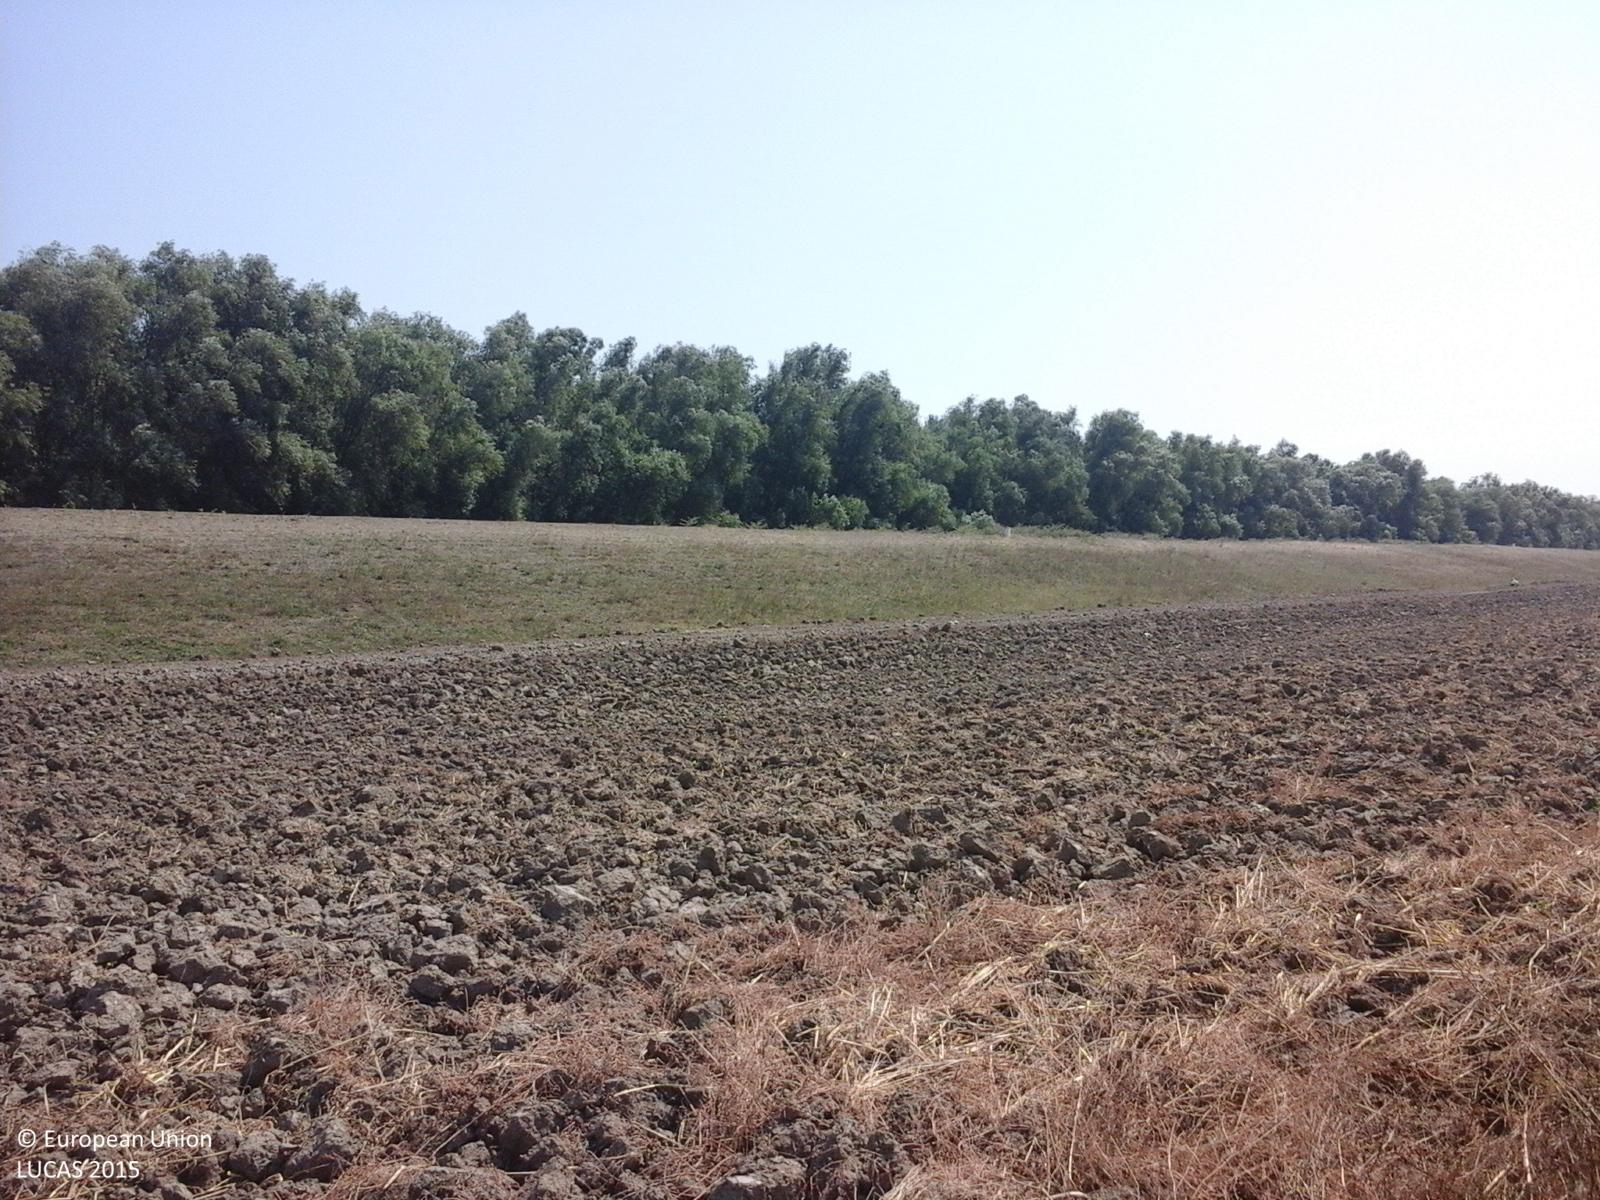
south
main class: Cropland
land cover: Lucerne
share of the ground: > 75 %
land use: Agriculture (excluding fallow land and kitchen gardens)
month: August
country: RO
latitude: 45.1299
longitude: 28.1612
